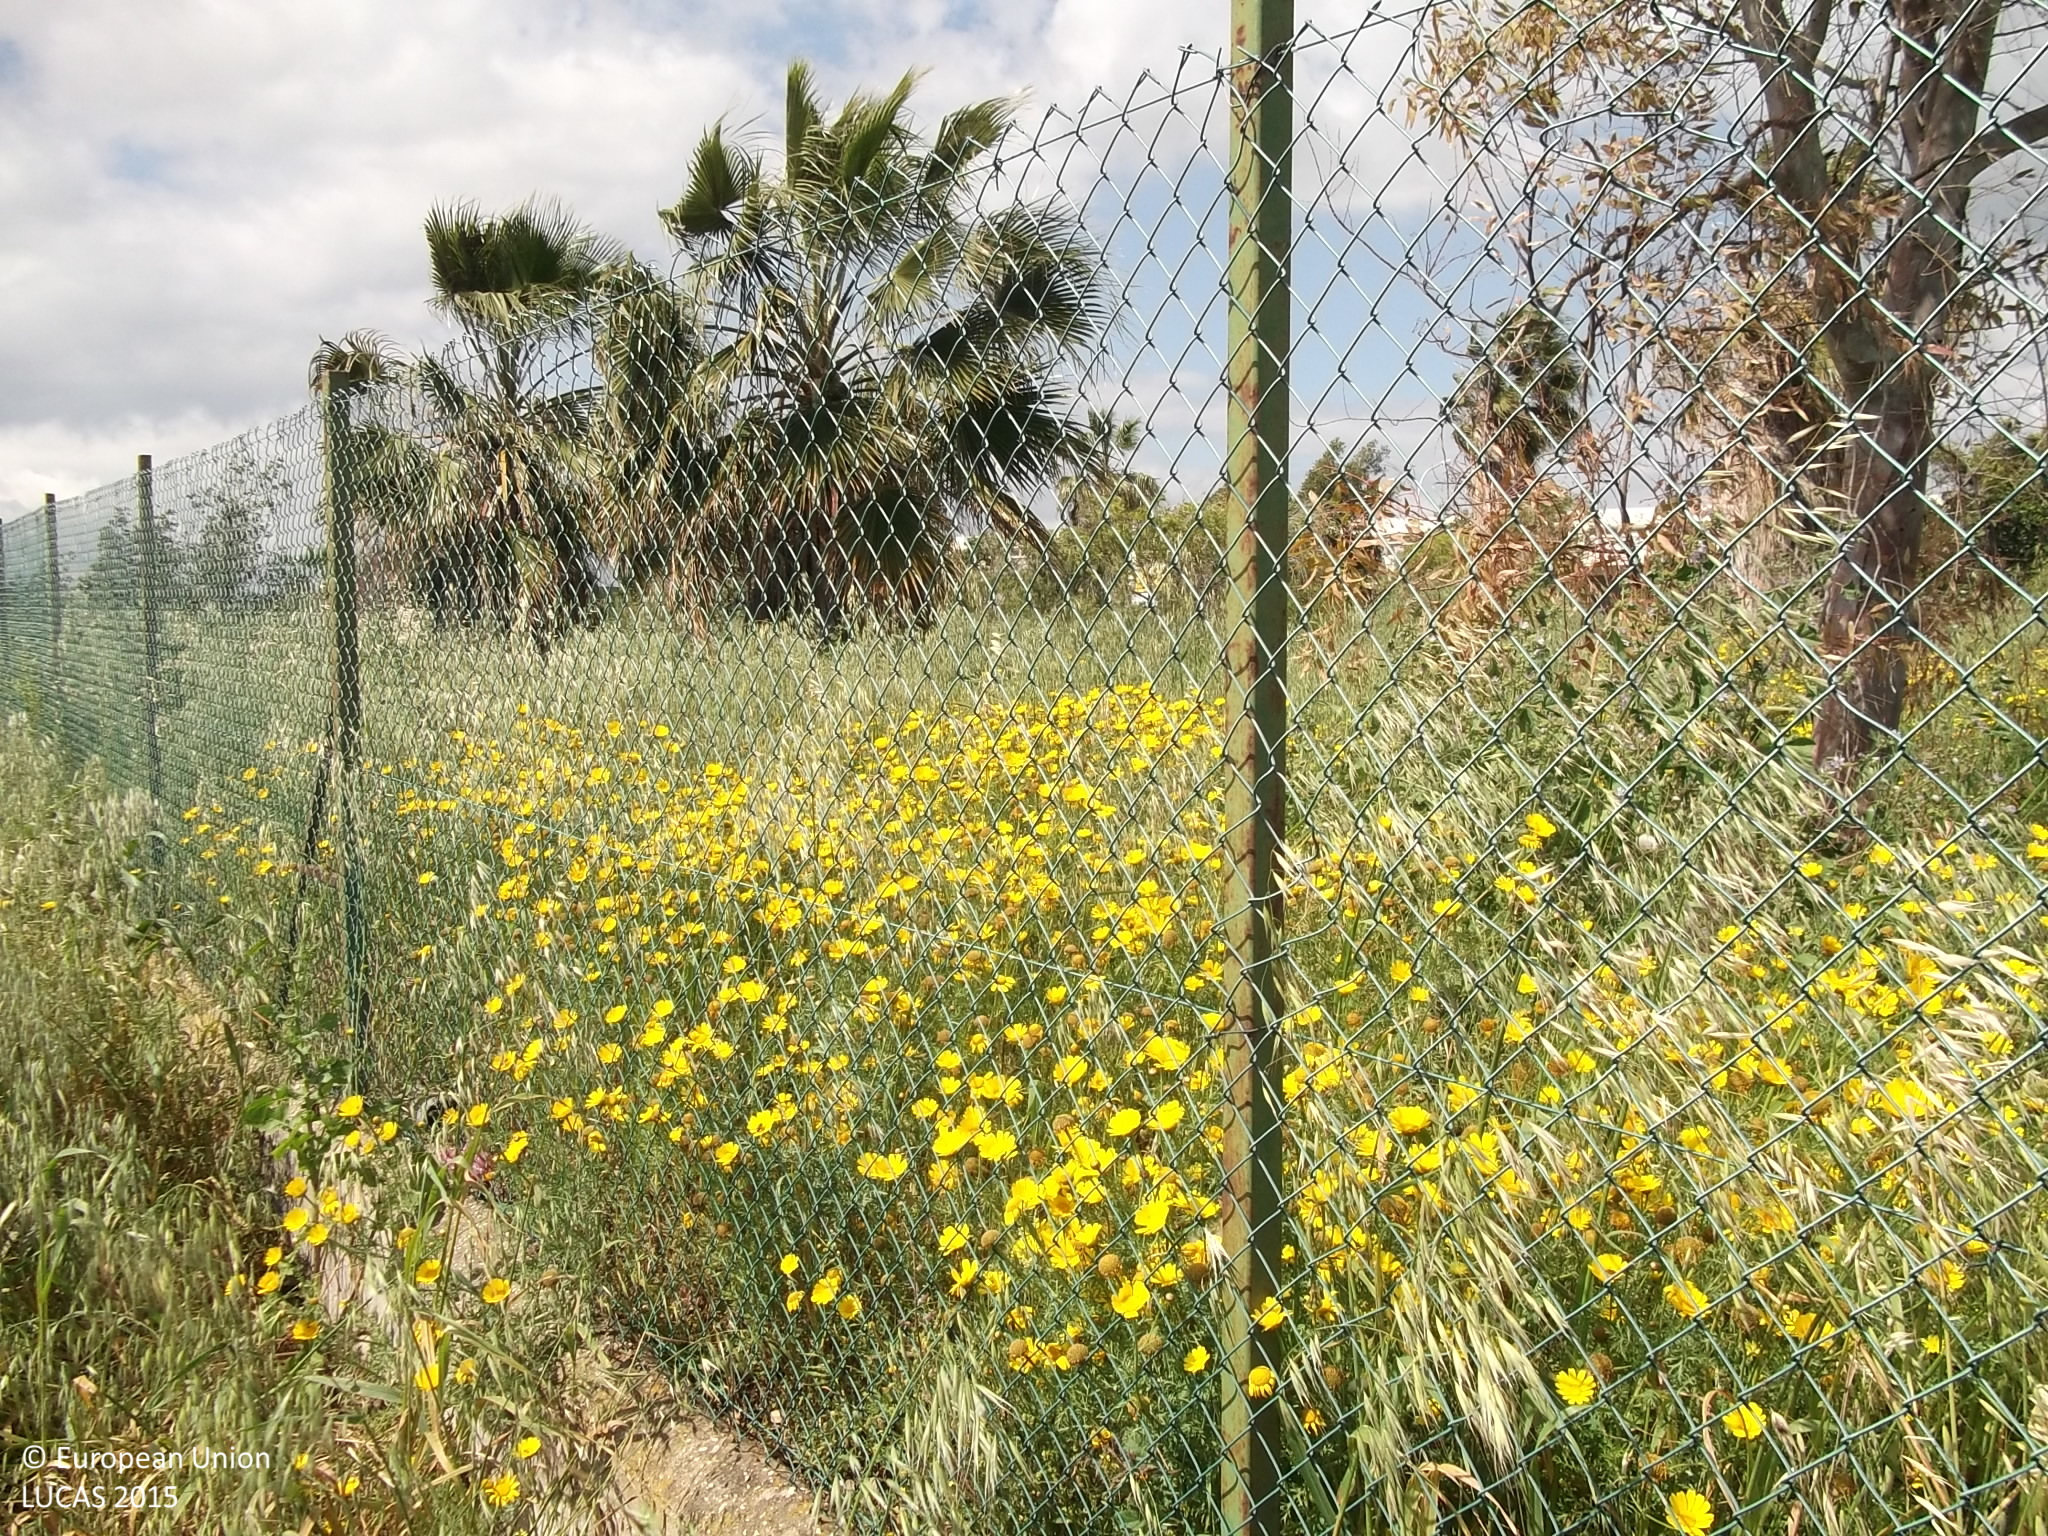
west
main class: Grassland
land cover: Grassland with sparse tree/shrub cover
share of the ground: > 75 %
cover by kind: herbaceous plants 95 %, broadleaved forest trees 5 %
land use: Semi-natural and natural areas not in use
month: April
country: CY
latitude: 34.8832
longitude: 33.5972
